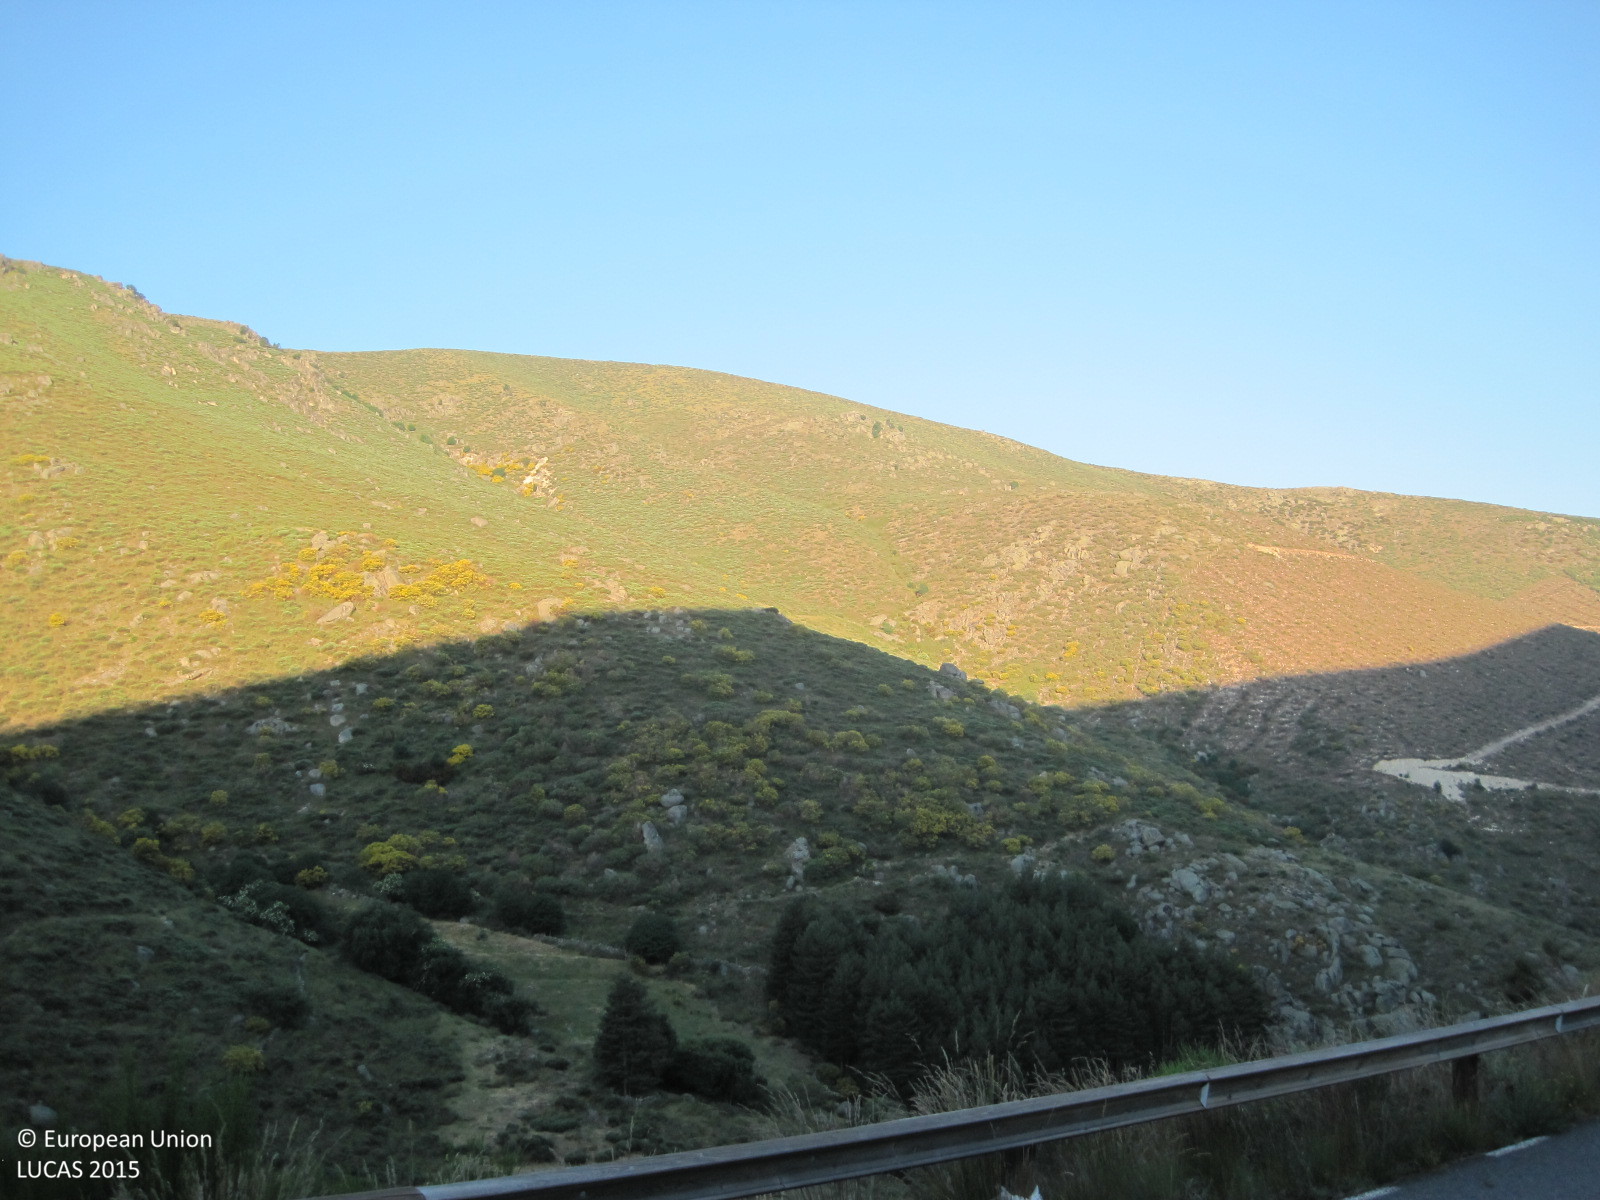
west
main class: Shrubland
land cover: Shrubland without tree cover
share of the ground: > 75 %
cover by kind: shrubs 100 %
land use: Semi-natural and natural areas not in use
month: June
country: ES
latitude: 40.3375
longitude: -5.2335
